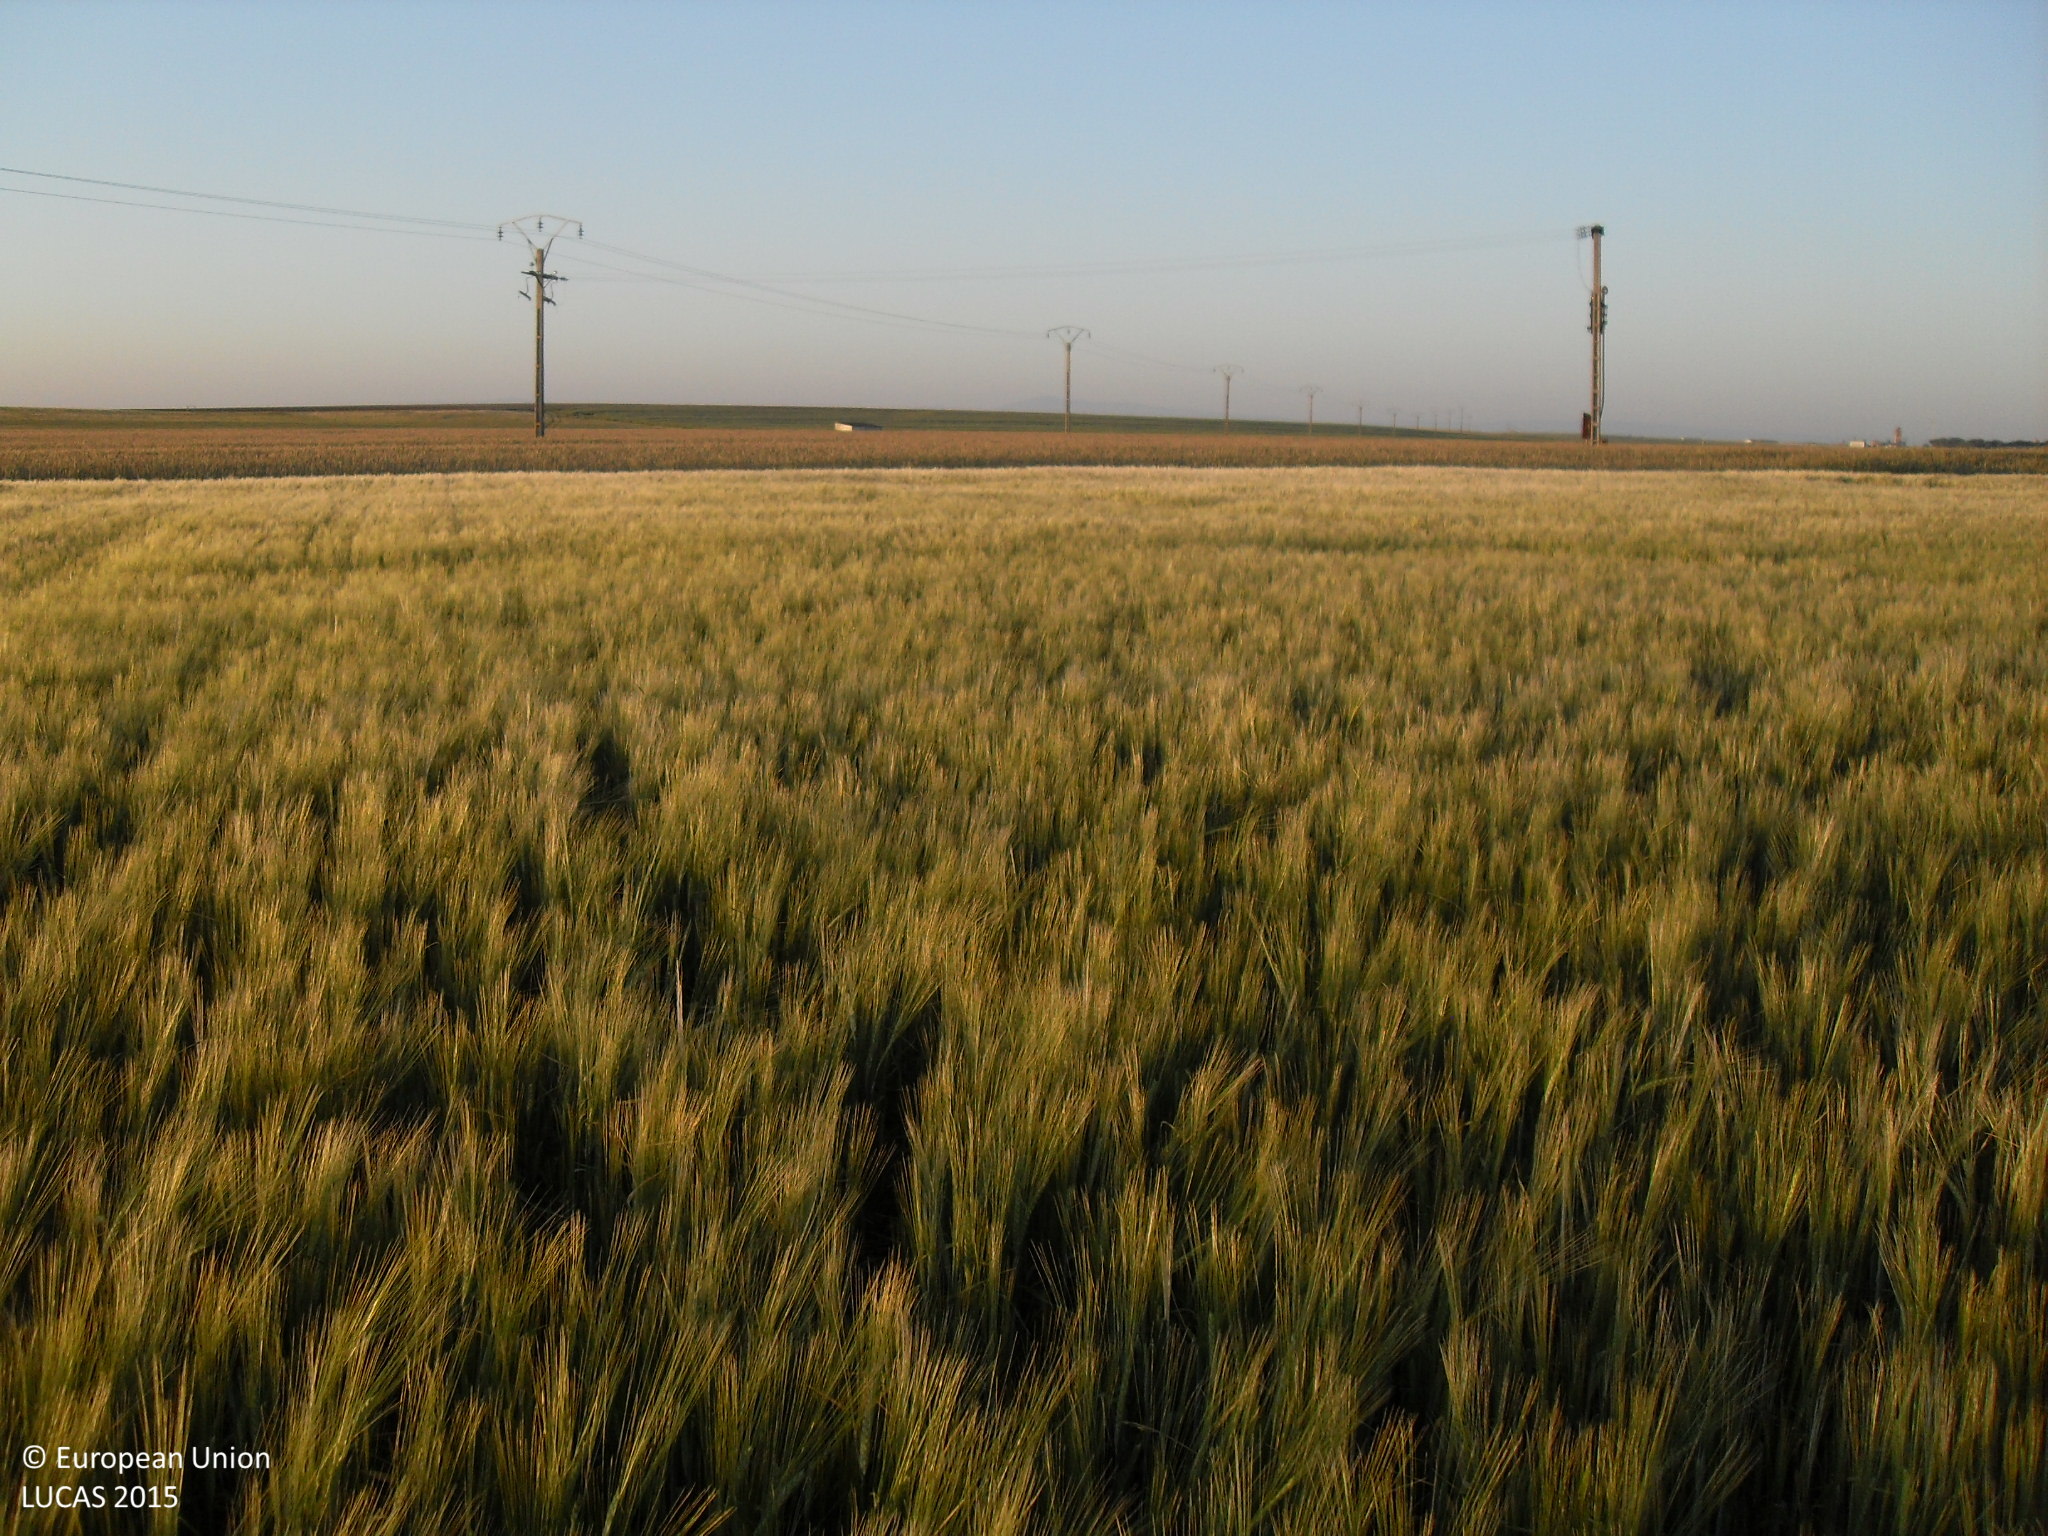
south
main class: Cropland
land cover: Barley
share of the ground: > 75 %
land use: Agriculture (excluding fallow land and kitchen gardens)
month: May
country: ES
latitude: 41.0420
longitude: -5.1892
